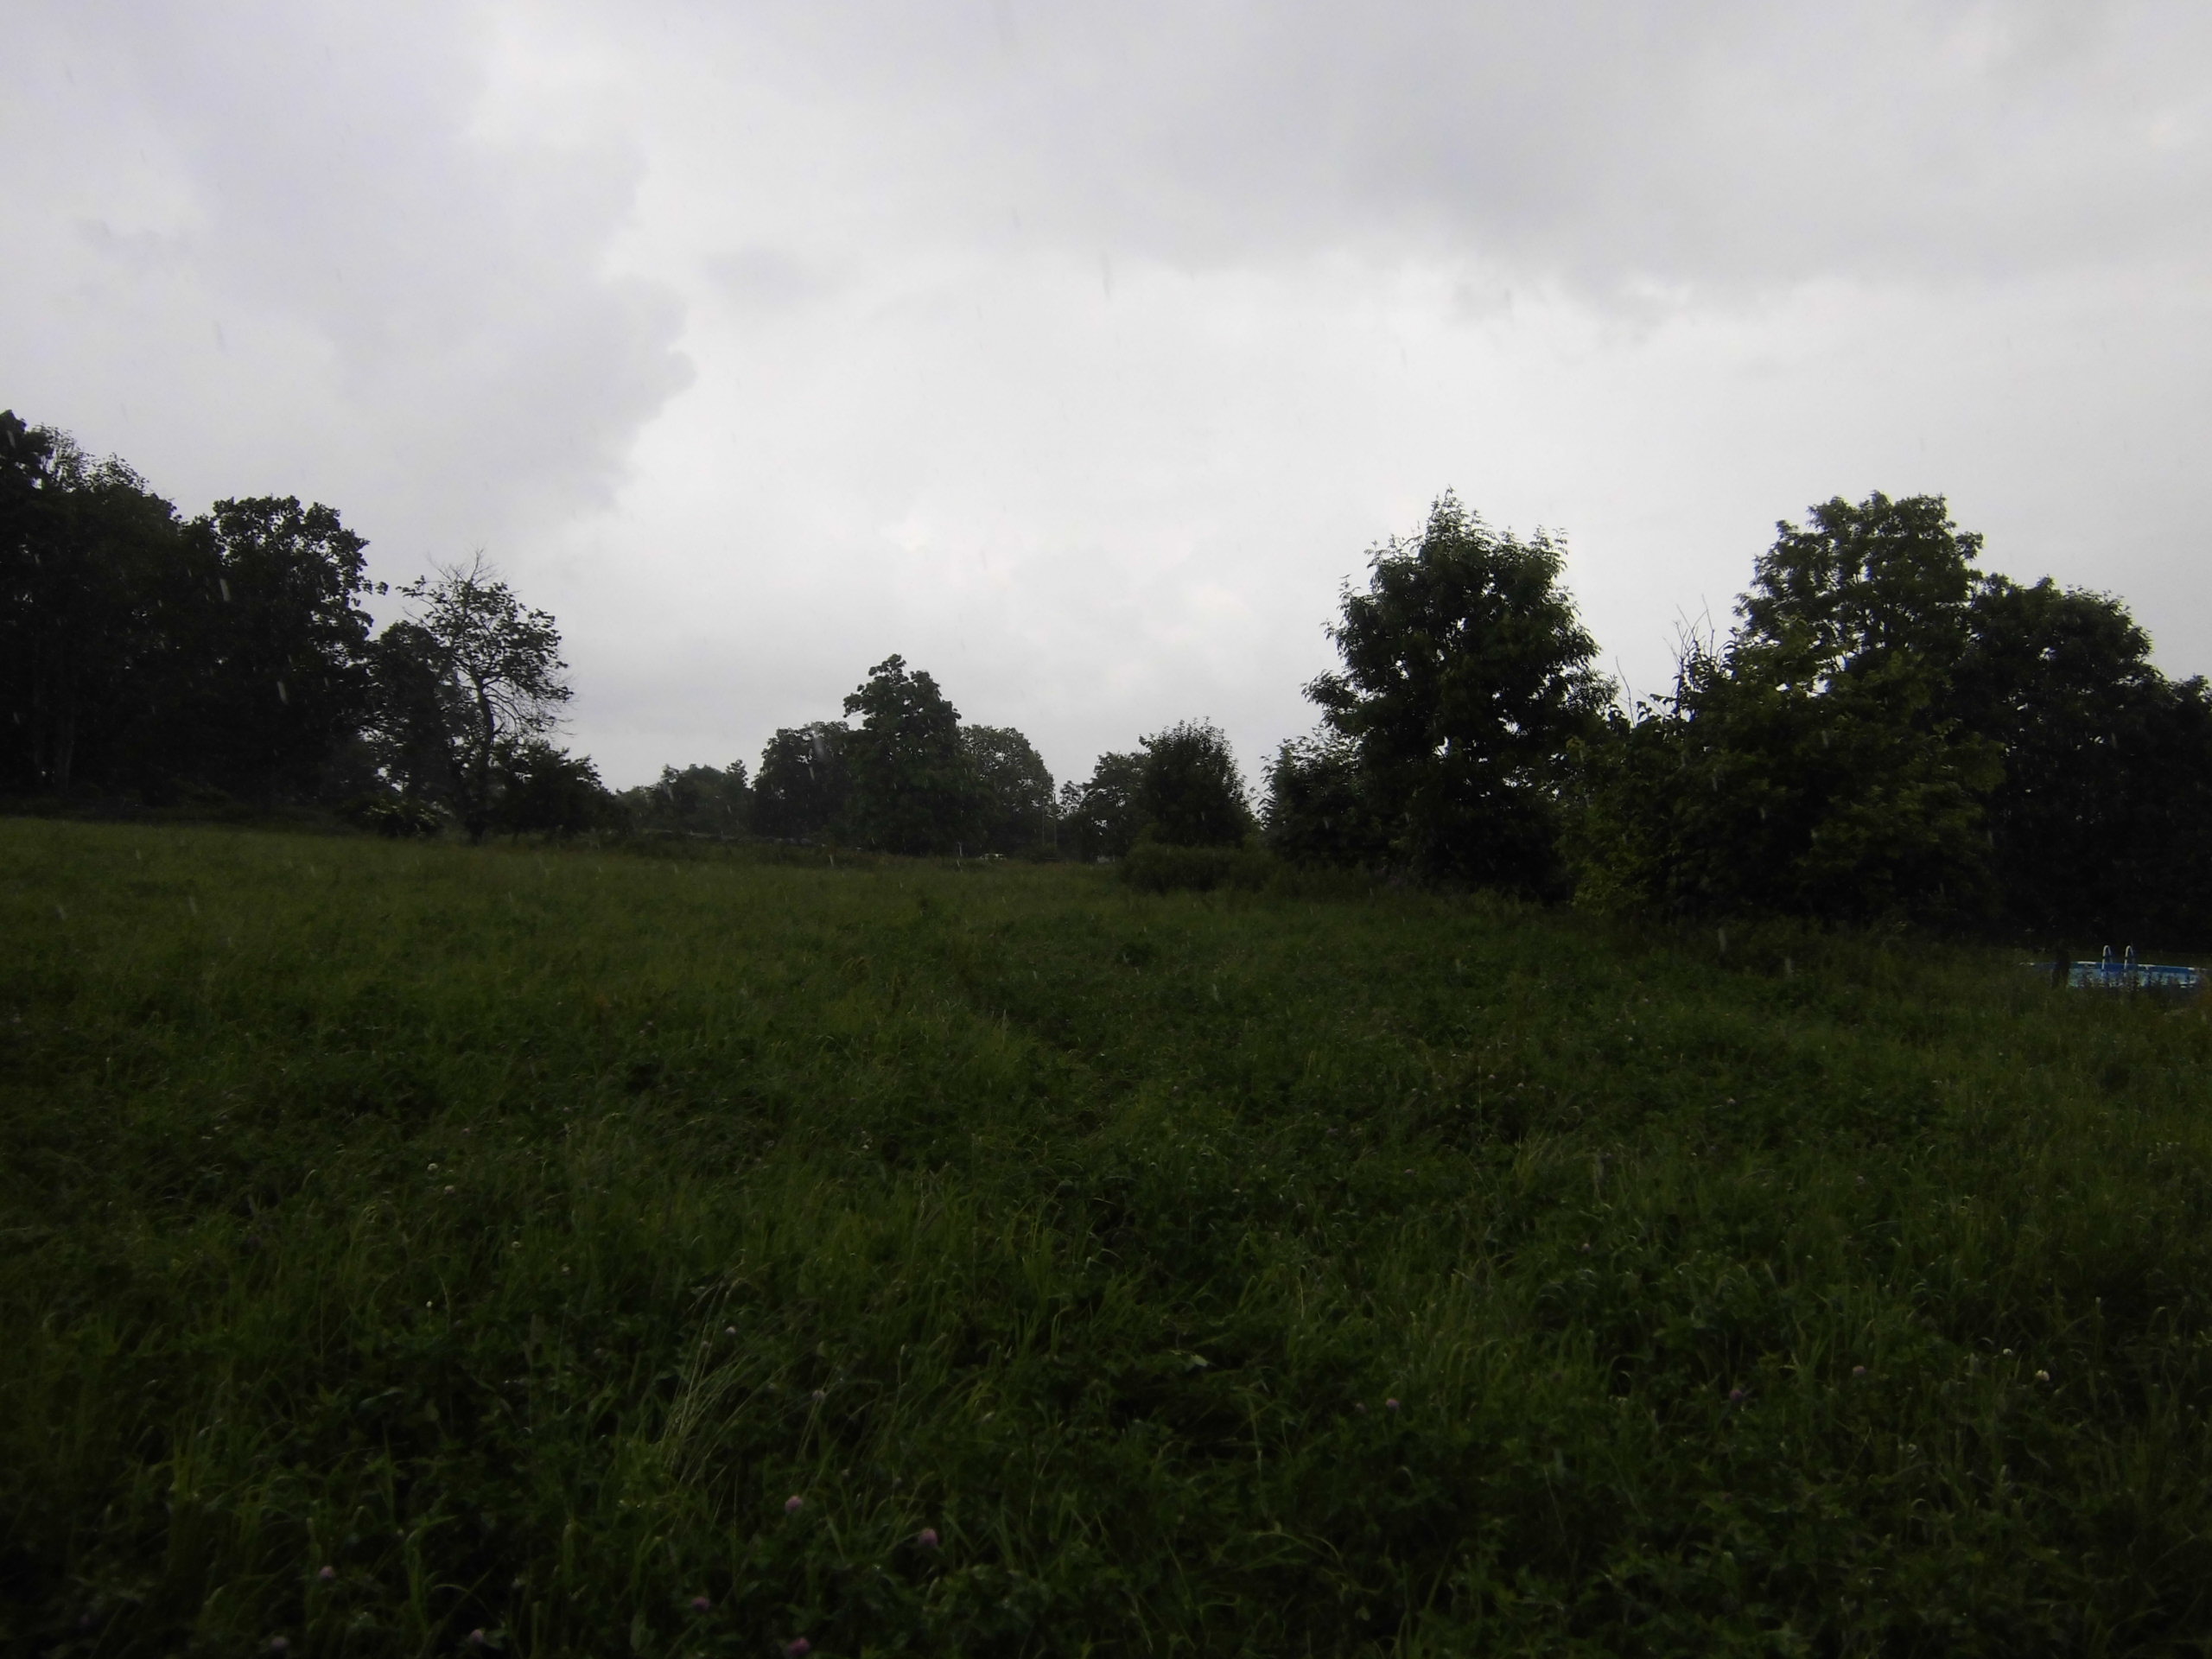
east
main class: Grassland
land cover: Grassland without tree/shrub cover
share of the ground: > 75 %
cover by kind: herbaceous plants 100 %
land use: Agriculture (excluding fallow land and kitchen gardens)
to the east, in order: Grassland without tree/shrub cover; Fences; Grassland without tree/shrub cover; Fences; Dry stone walls; Groves; Grassland without tree/shrub cover; Fences; Paved roads, cycling and walking lanes; Grass margins; Artificial constructions in urban areas; Grassland without tree/shrub cover
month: July
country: SE
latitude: 57.4079
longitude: 14.9399
